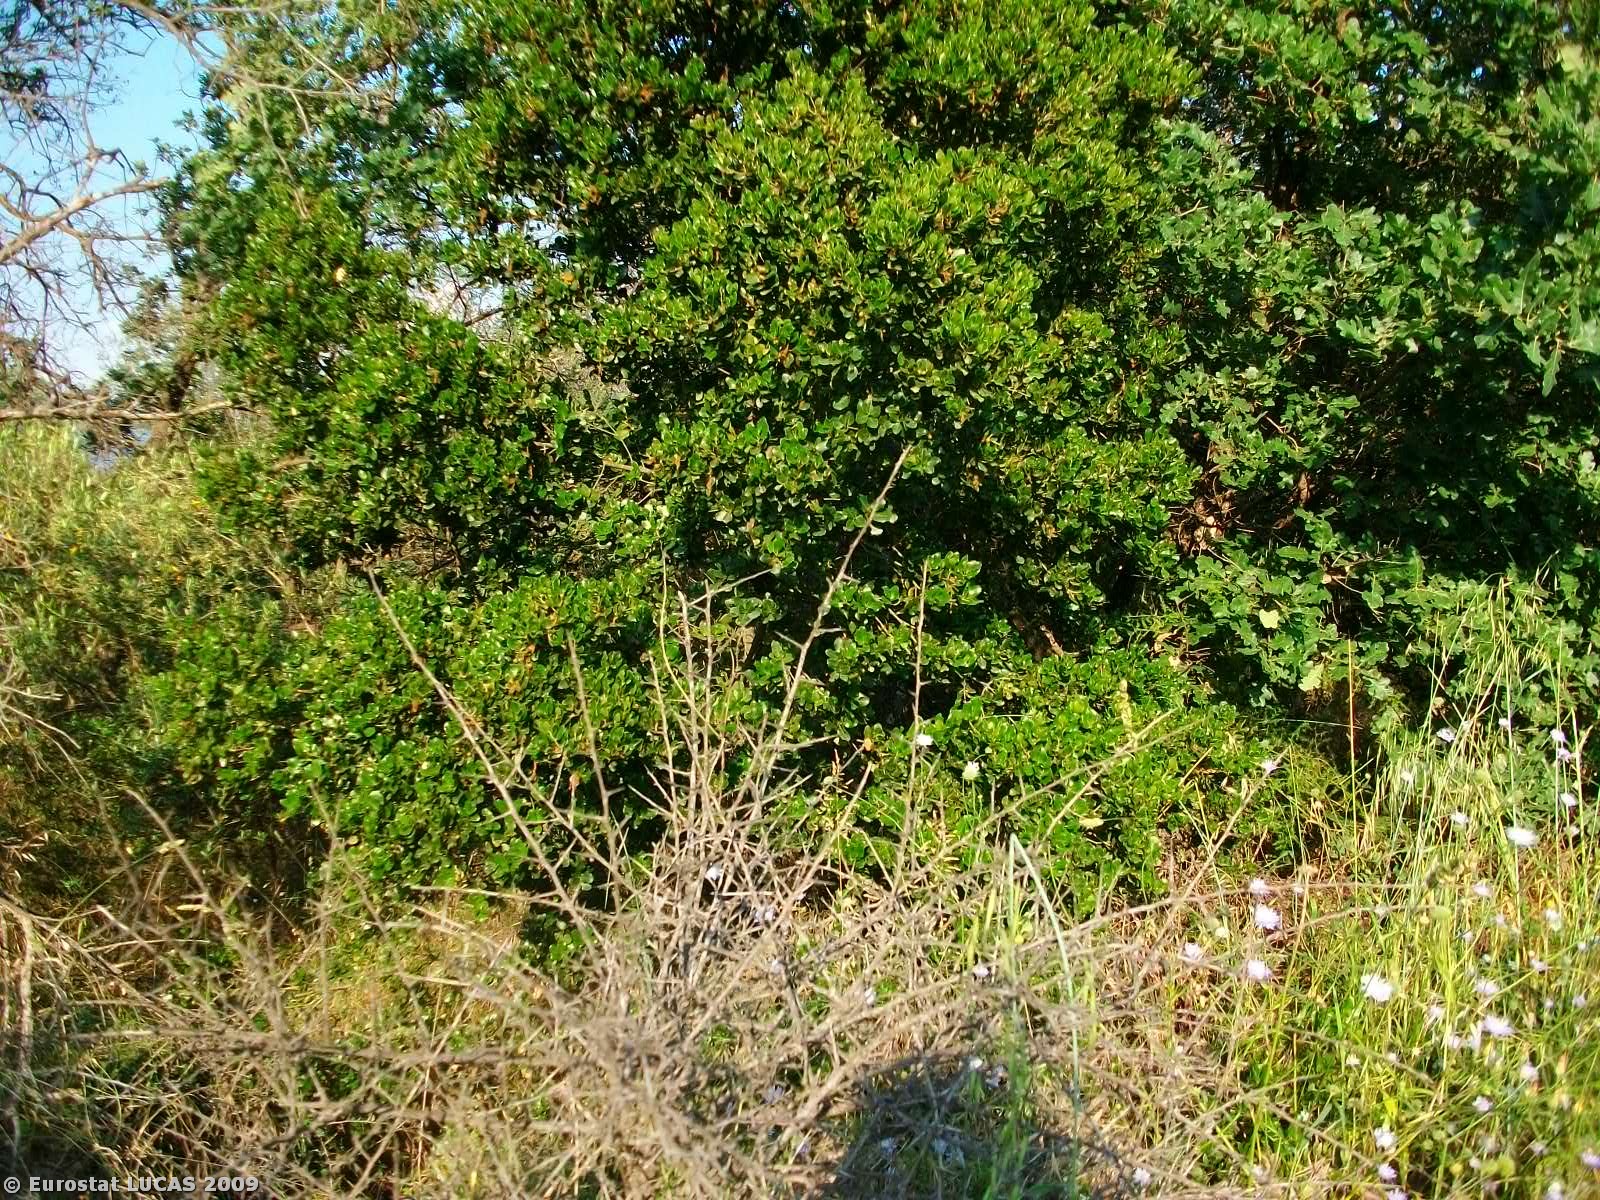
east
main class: Woodland
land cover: Broadleaved woodland
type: broadleaved evergreen forest
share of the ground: > 75 %
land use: Forestry
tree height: > 5 m
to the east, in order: Broadleaved woodland; Grassland with sparse tree/shrub cover; Broadleaved woodland; Arable land (only in case pi)
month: May
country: GR
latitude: 37.1793
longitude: 22.3355
